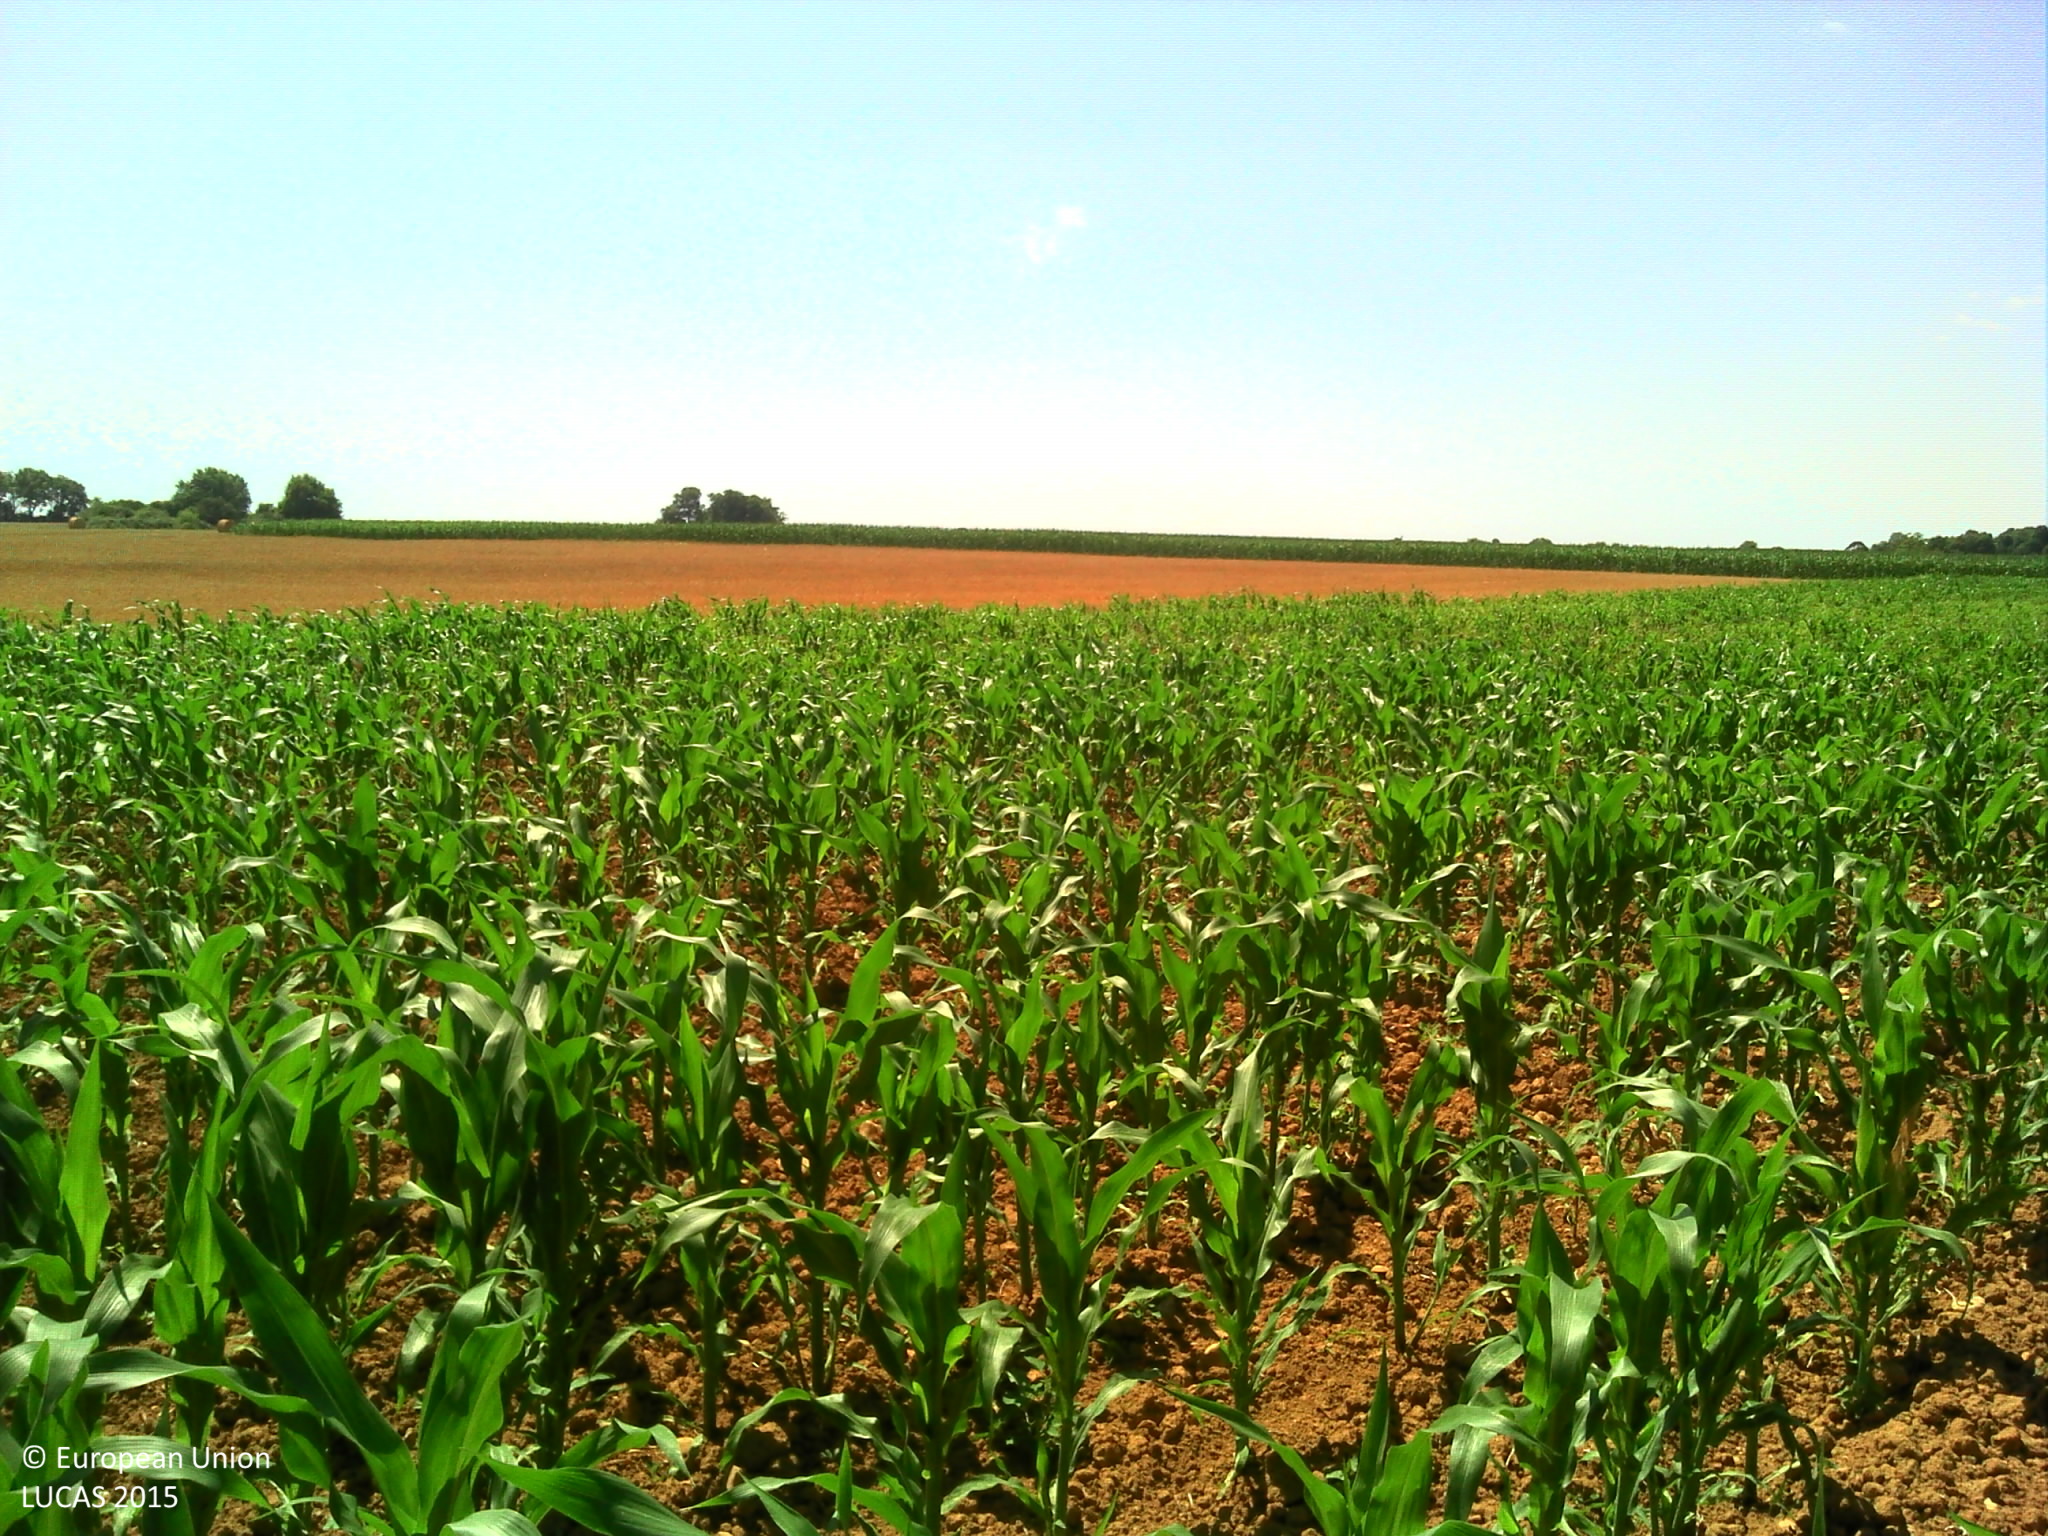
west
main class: Cropland
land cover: Maize
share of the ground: > 75 %
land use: Agriculture (excluding fallow land and kitchen gardens)
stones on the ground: < 10 %
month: July
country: FR
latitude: 46.4718
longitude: -1.3533
